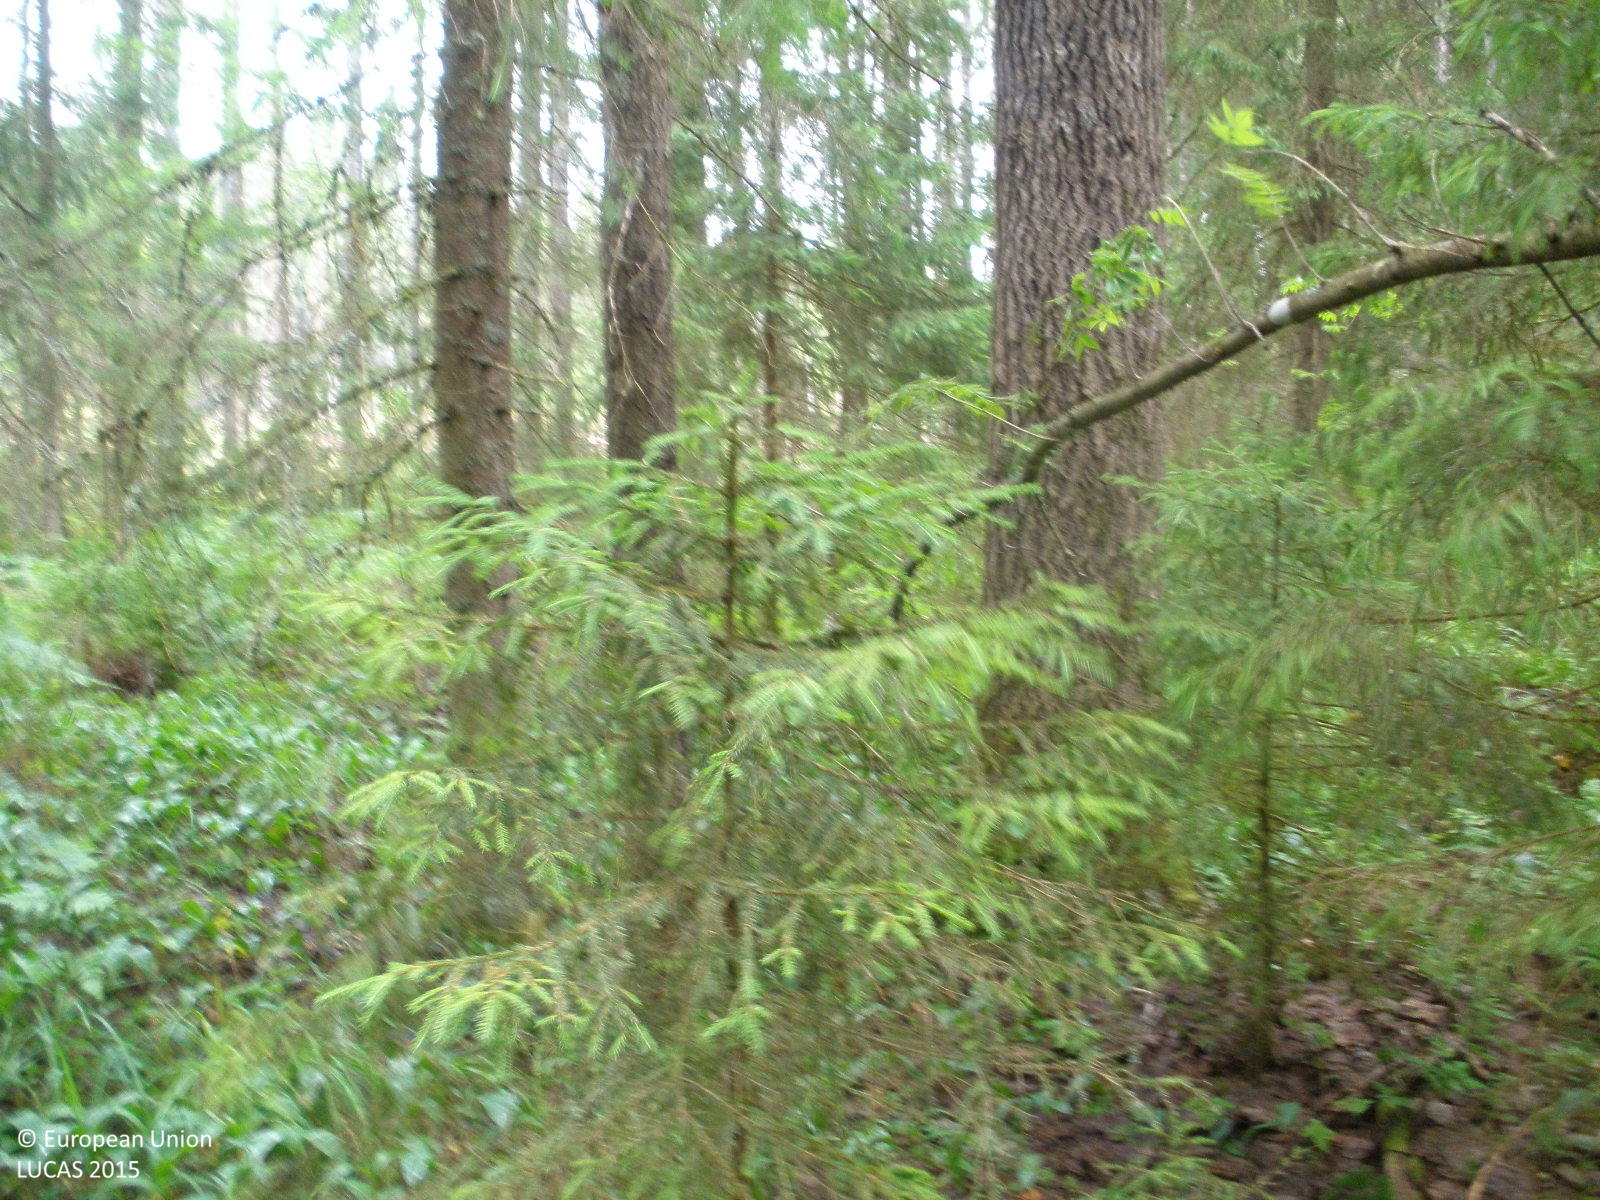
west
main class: Woodland
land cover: Spruce dominated mixed woodland
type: boreal forest
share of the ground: > 75 %
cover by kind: coniferous forest trees 55 %, broadleaved forest trees 30 %, herbaceous plants 15 %
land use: Forestry
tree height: > 5 m
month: July
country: FI
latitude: 61.4138
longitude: 24.8129
